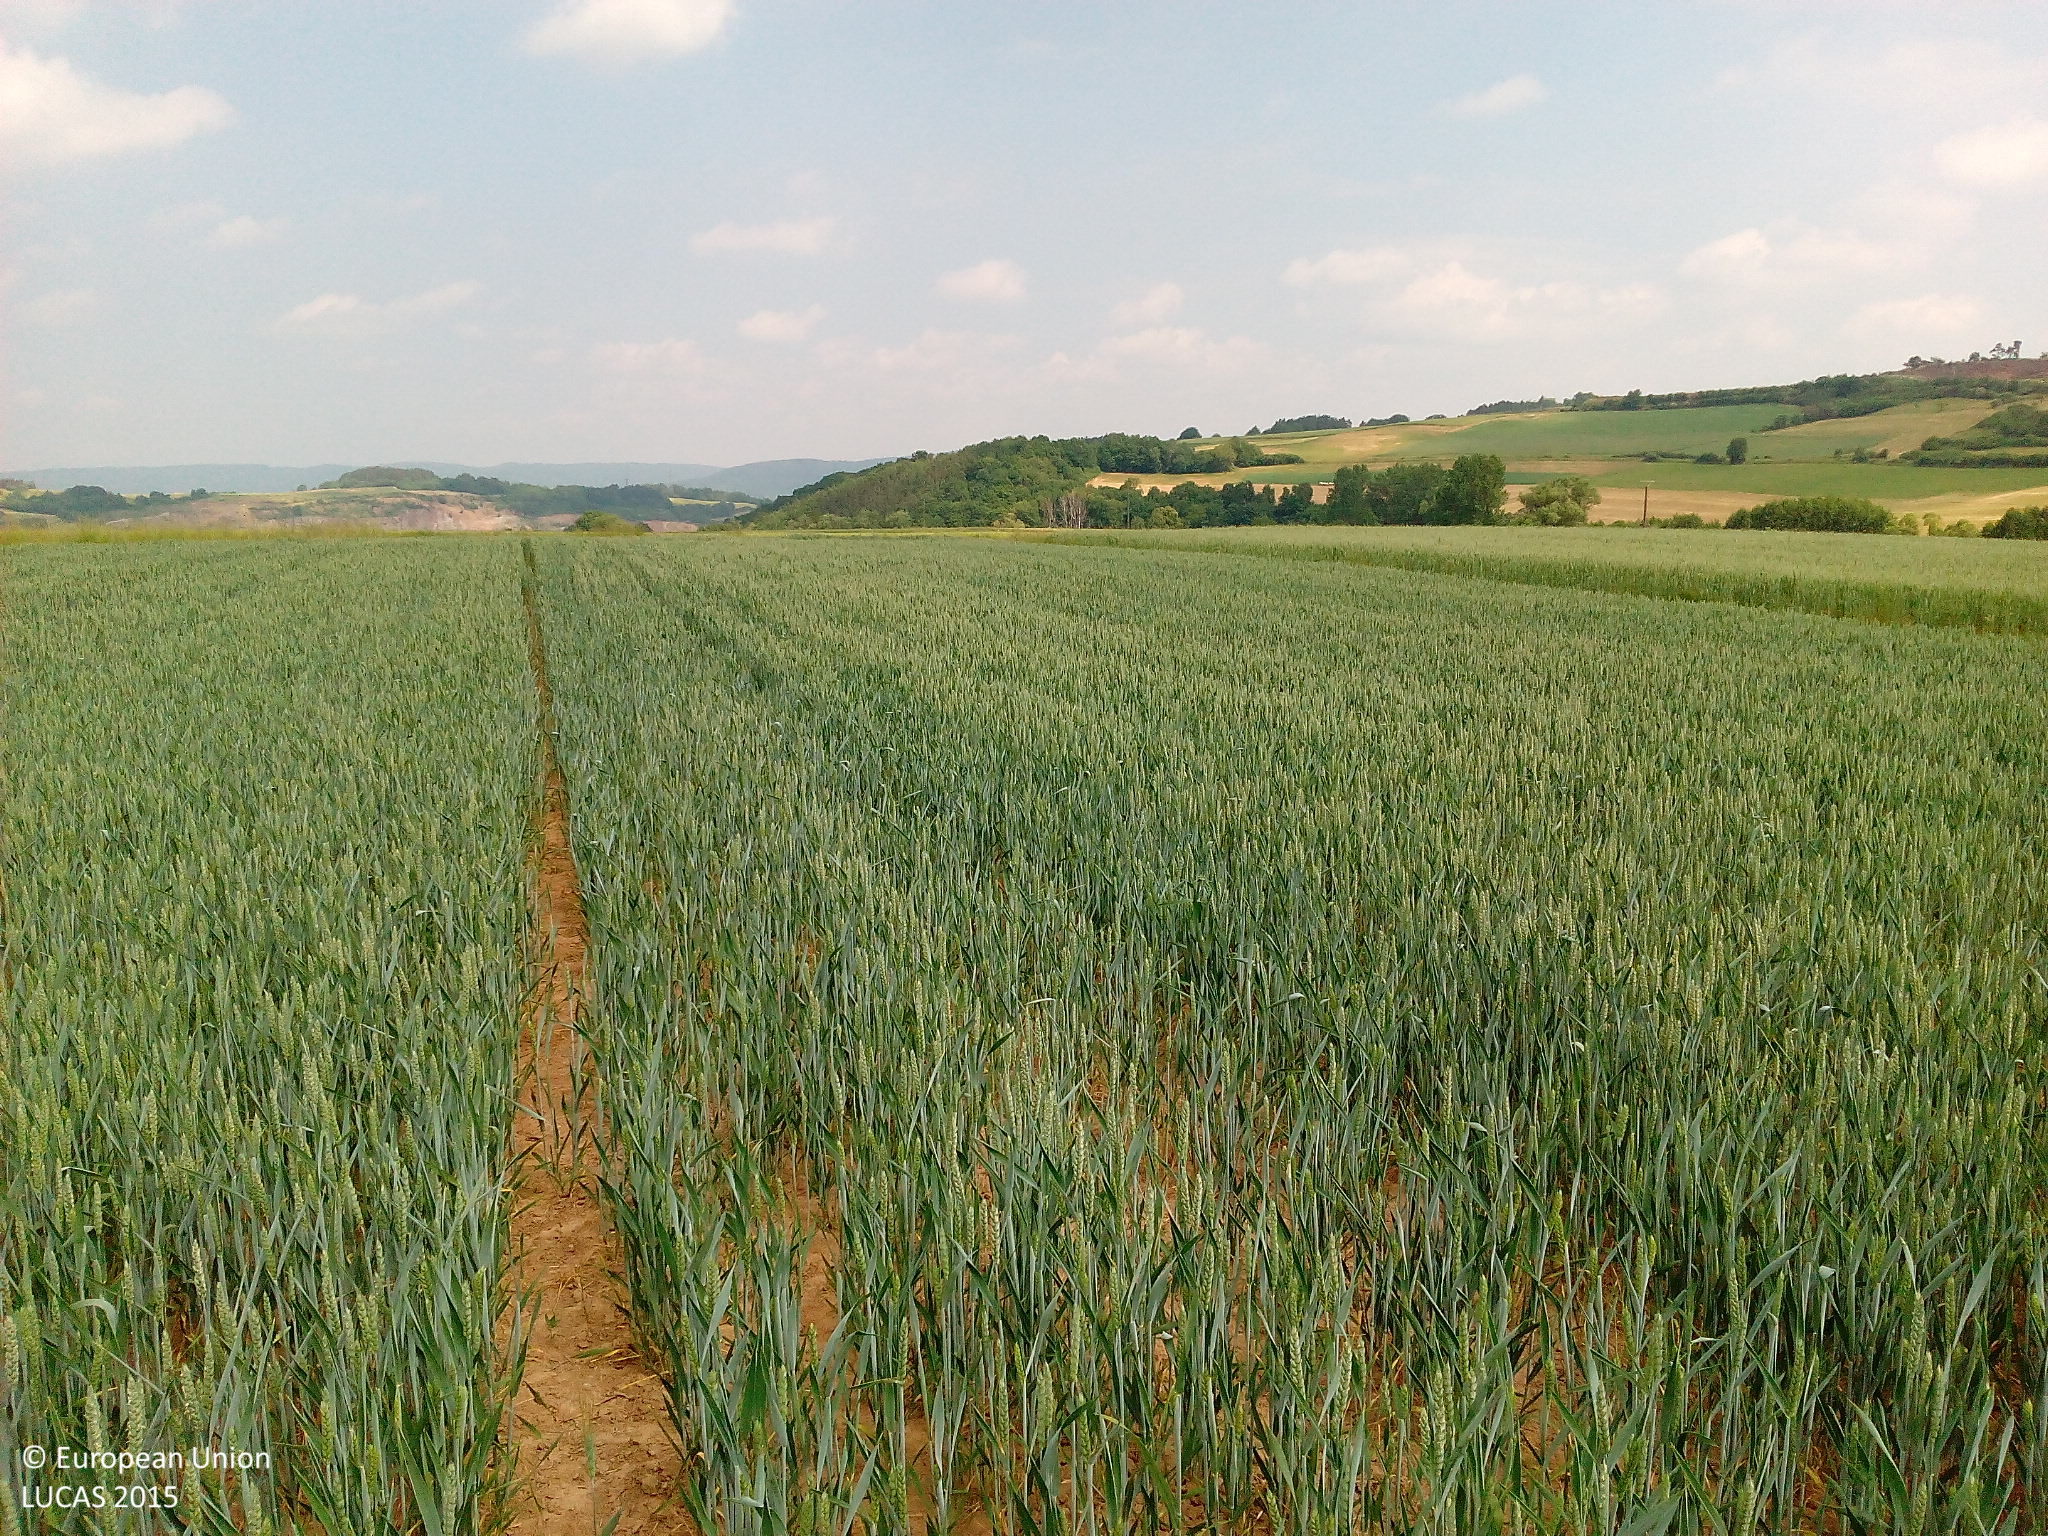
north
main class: Cropland
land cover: Common wheat
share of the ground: > 75 %
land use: Agriculture (excluding fallow land and kitchen gardens)
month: June
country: DE
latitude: 51.0108
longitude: 9.6438
